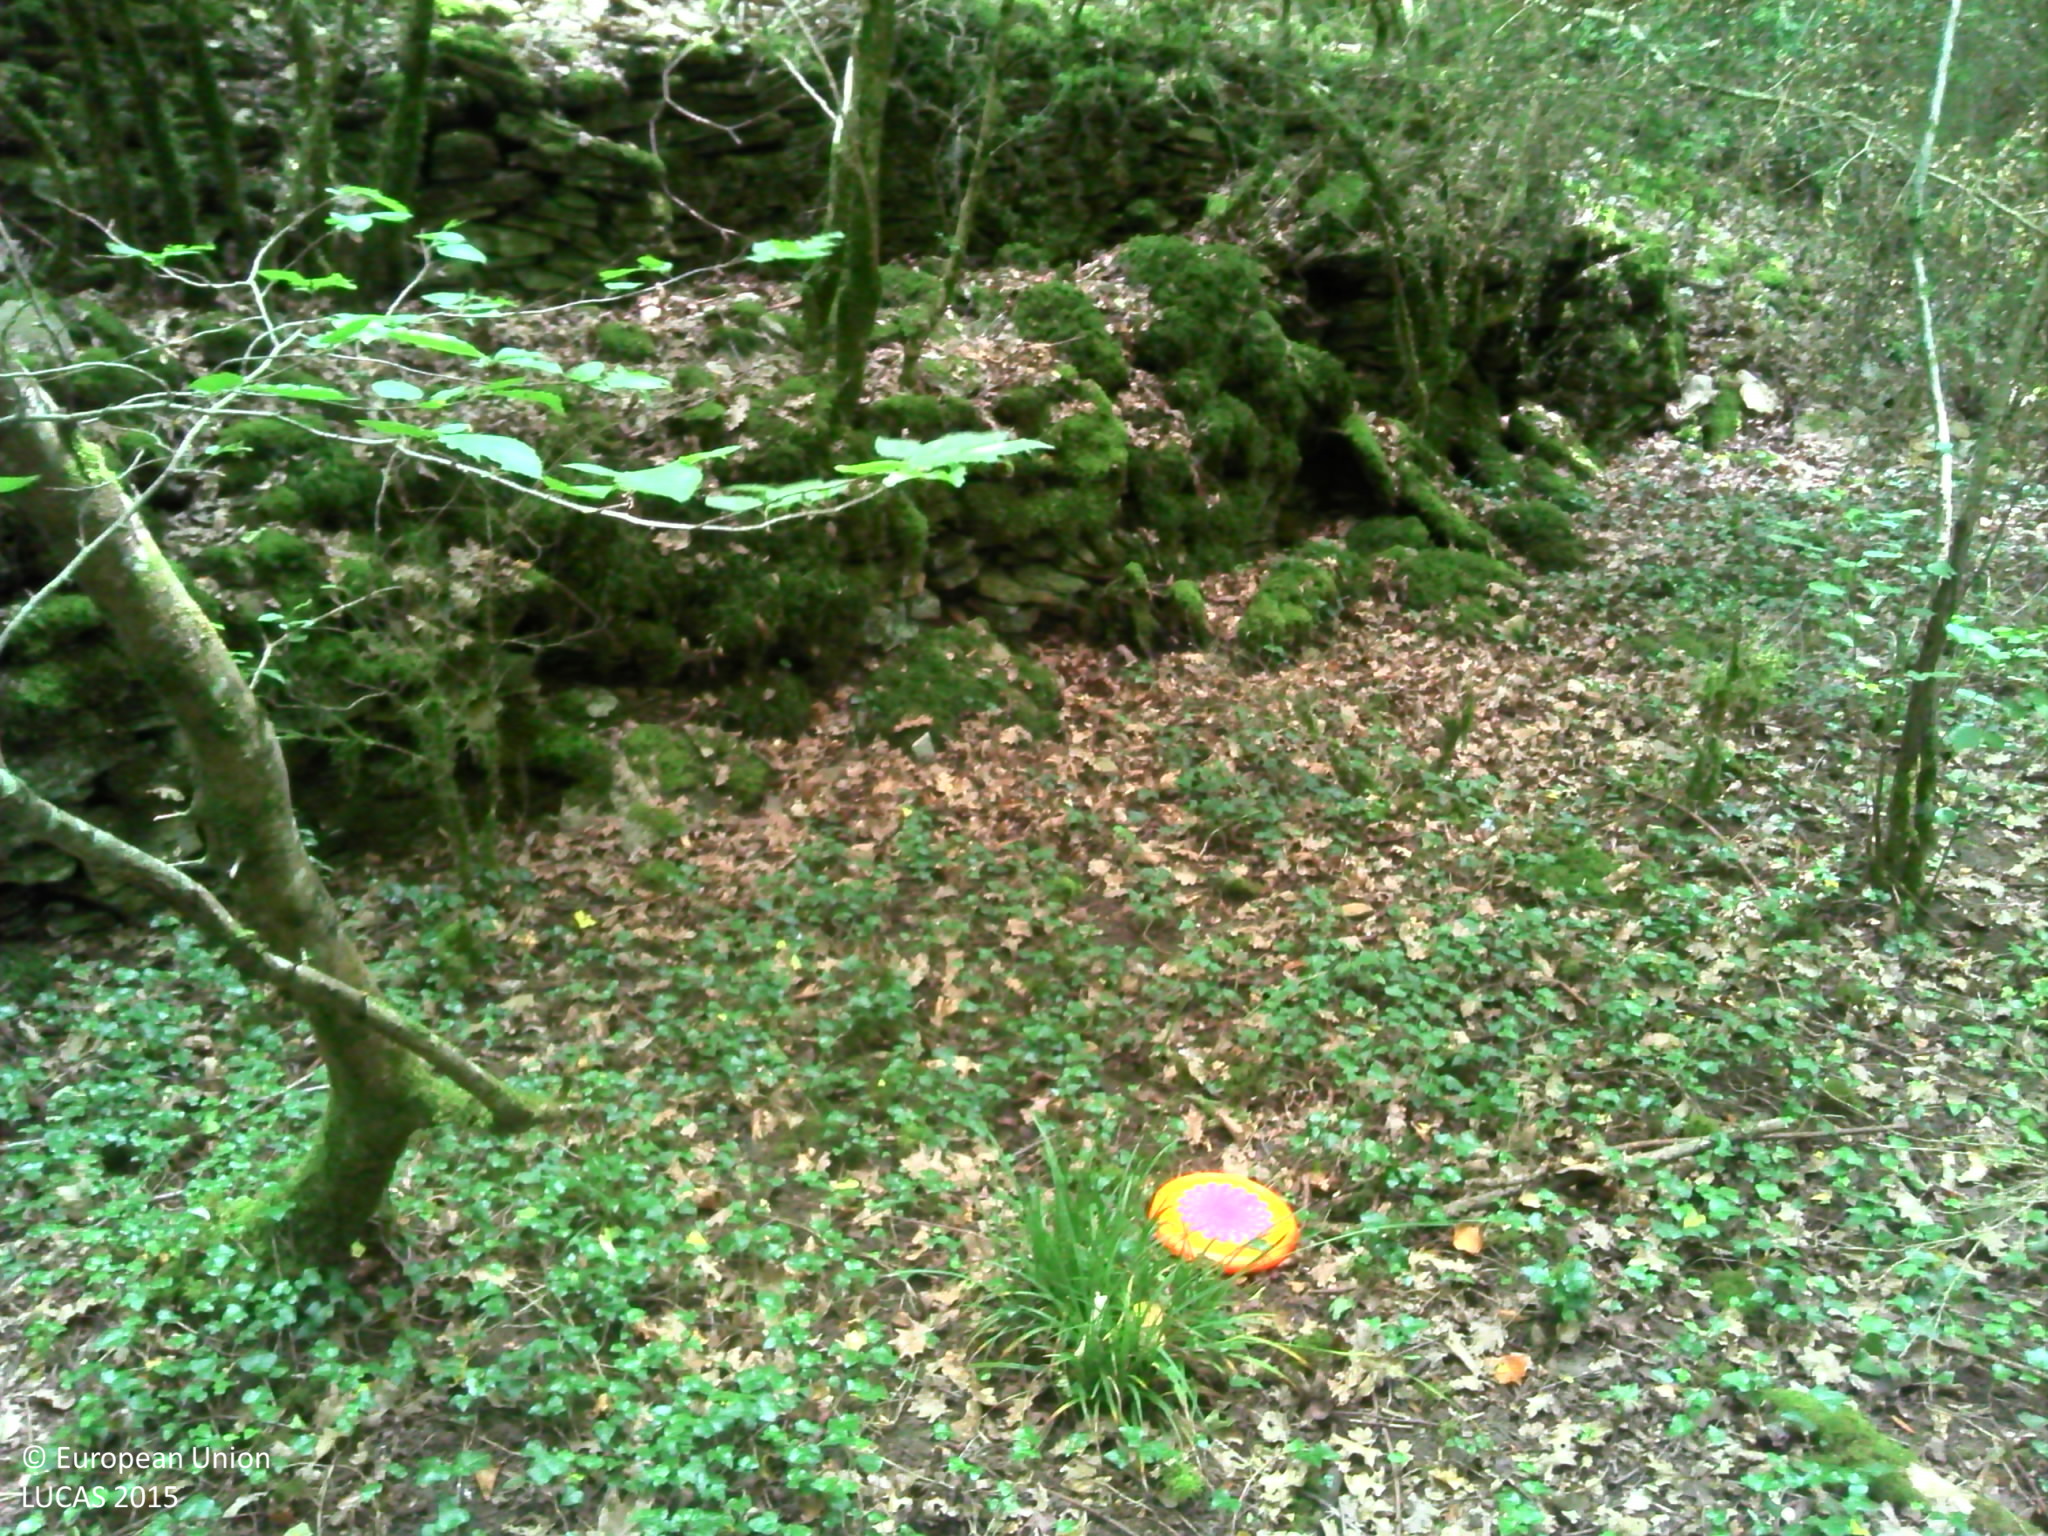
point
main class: Woodland
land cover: Broadleaved woodland
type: mesophytic deciduous forest
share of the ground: > 75 %
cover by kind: broadleaved forest trees 60 %, herbaceous plants 35 %, lichens and mosses 5 %
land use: Forestry
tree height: > 5 m
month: June
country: FR
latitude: 46.5687
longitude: 4.8222
